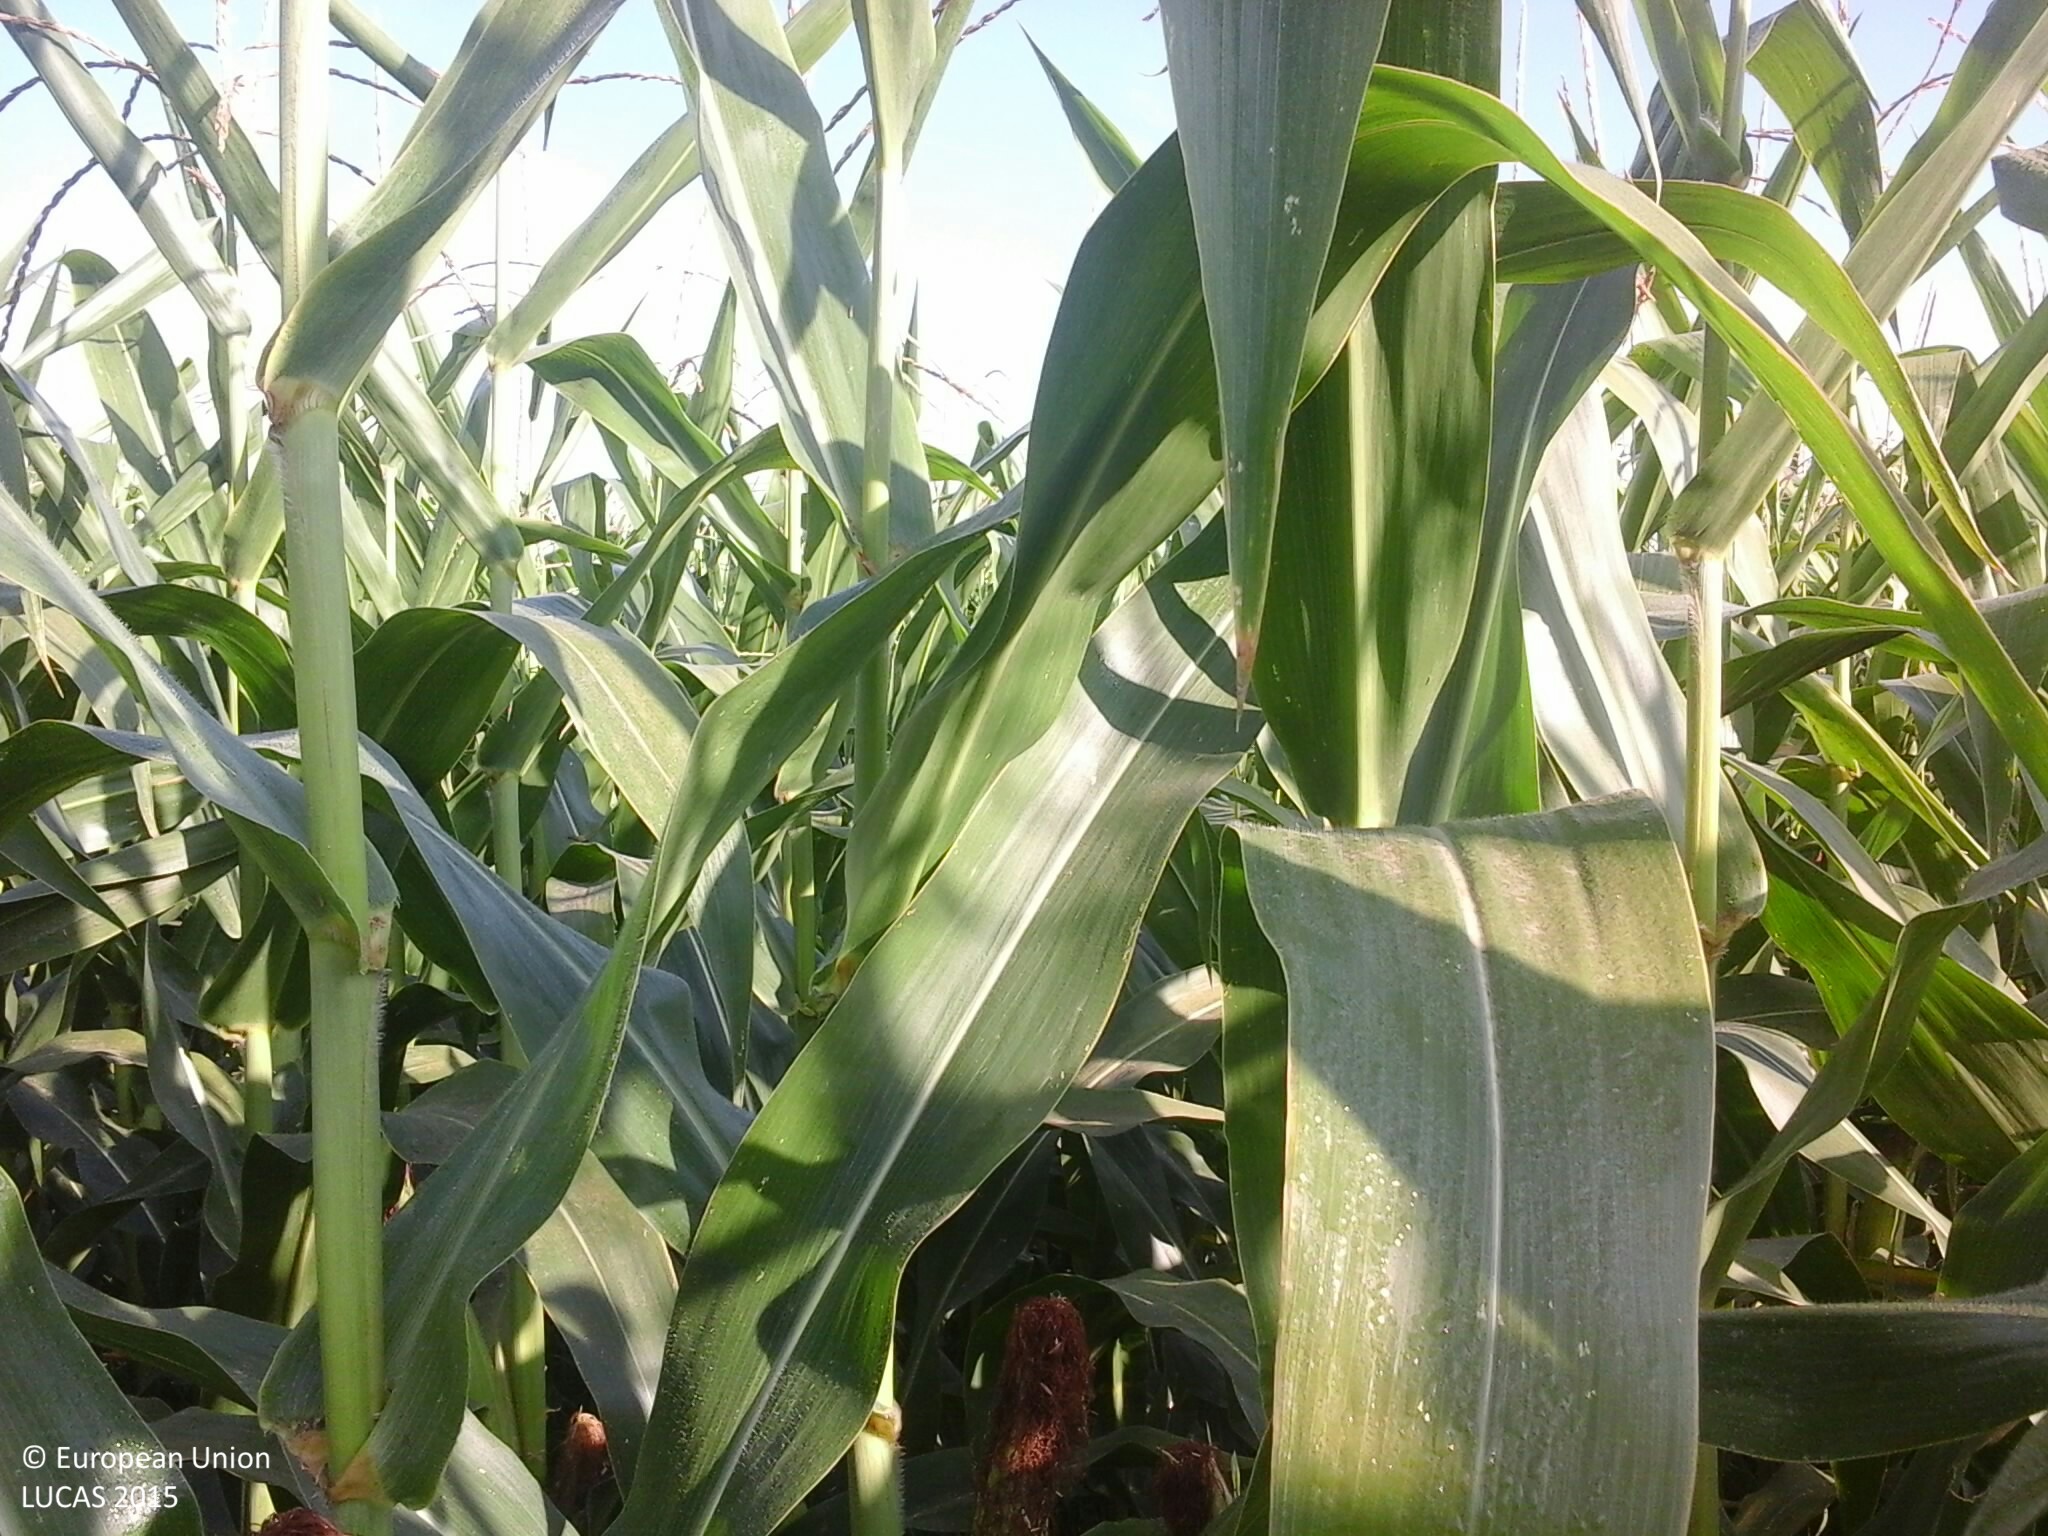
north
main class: Cropland
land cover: Maize
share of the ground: > 75 %
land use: Agriculture (excluding fallow land and kitchen gardens)
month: July
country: HU
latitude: 48.2003
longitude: 22.3421
